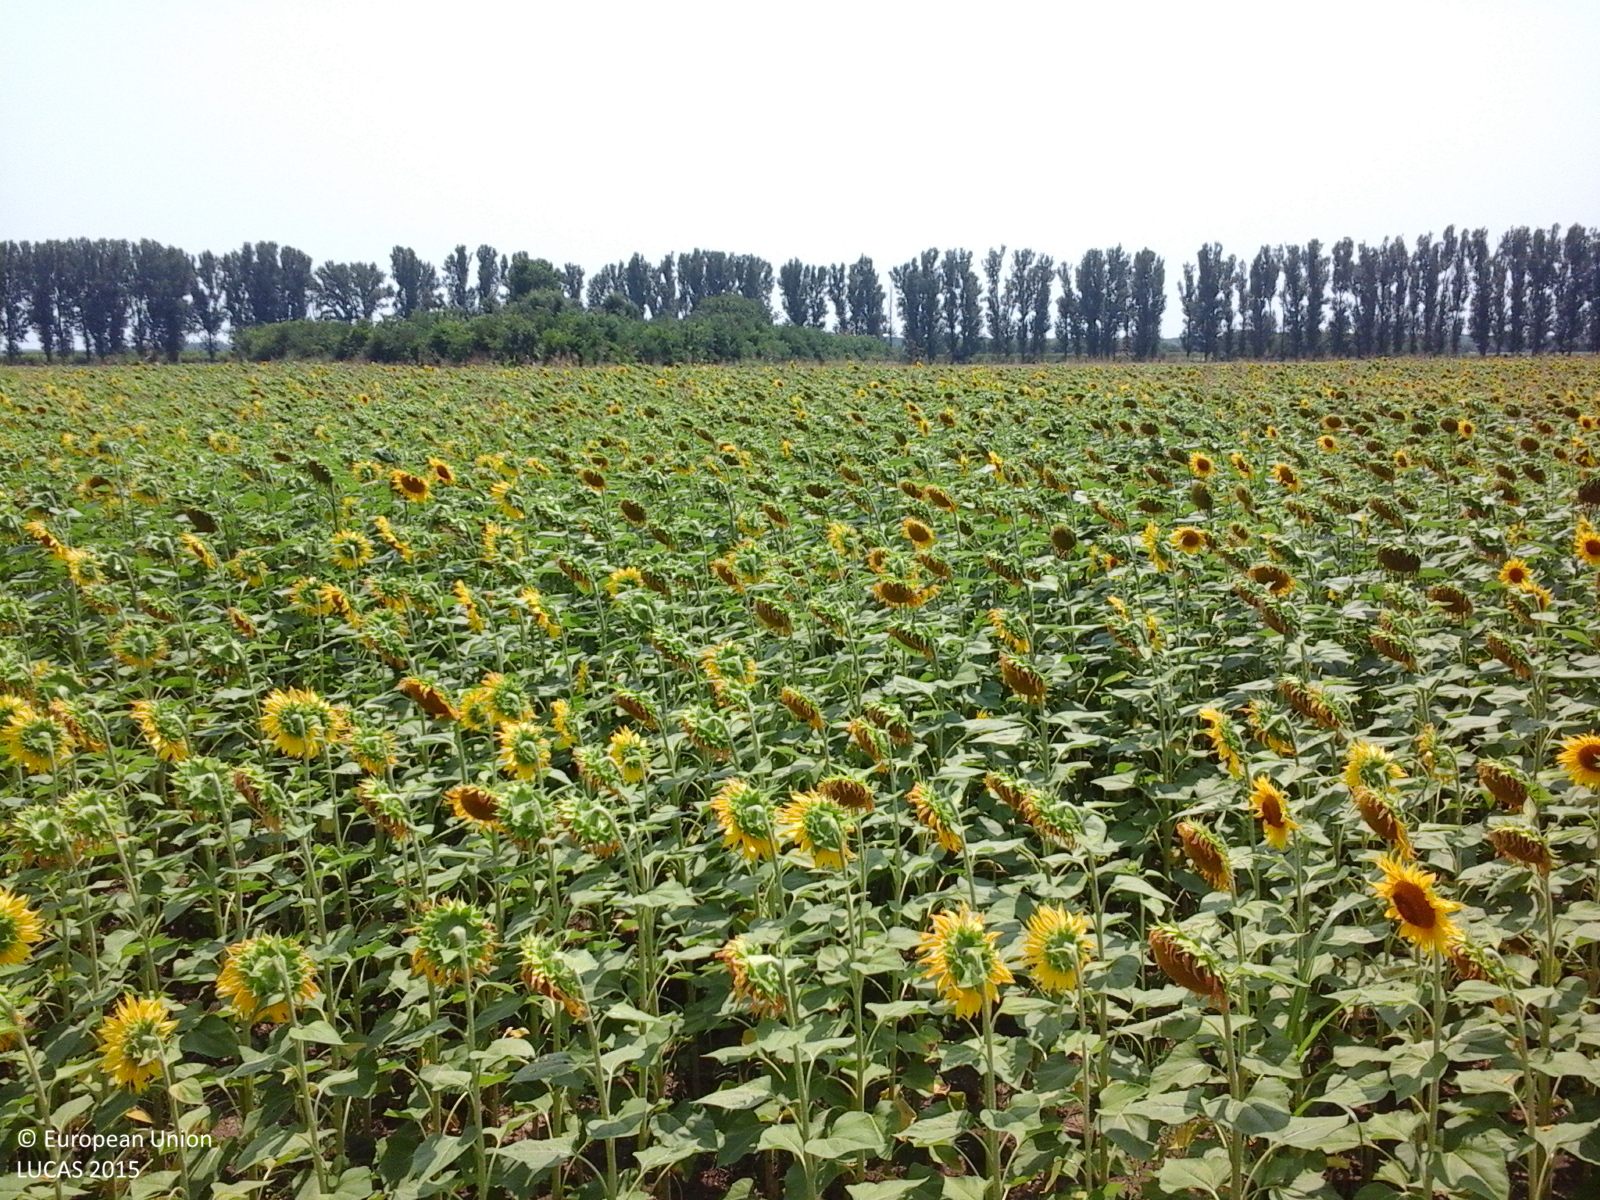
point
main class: Cropland
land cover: Sunflower
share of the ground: > 75 %
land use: Agriculture (excluding fallow land and kitchen gardens)
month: July
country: RO
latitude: 44.7251
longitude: 26.2860
